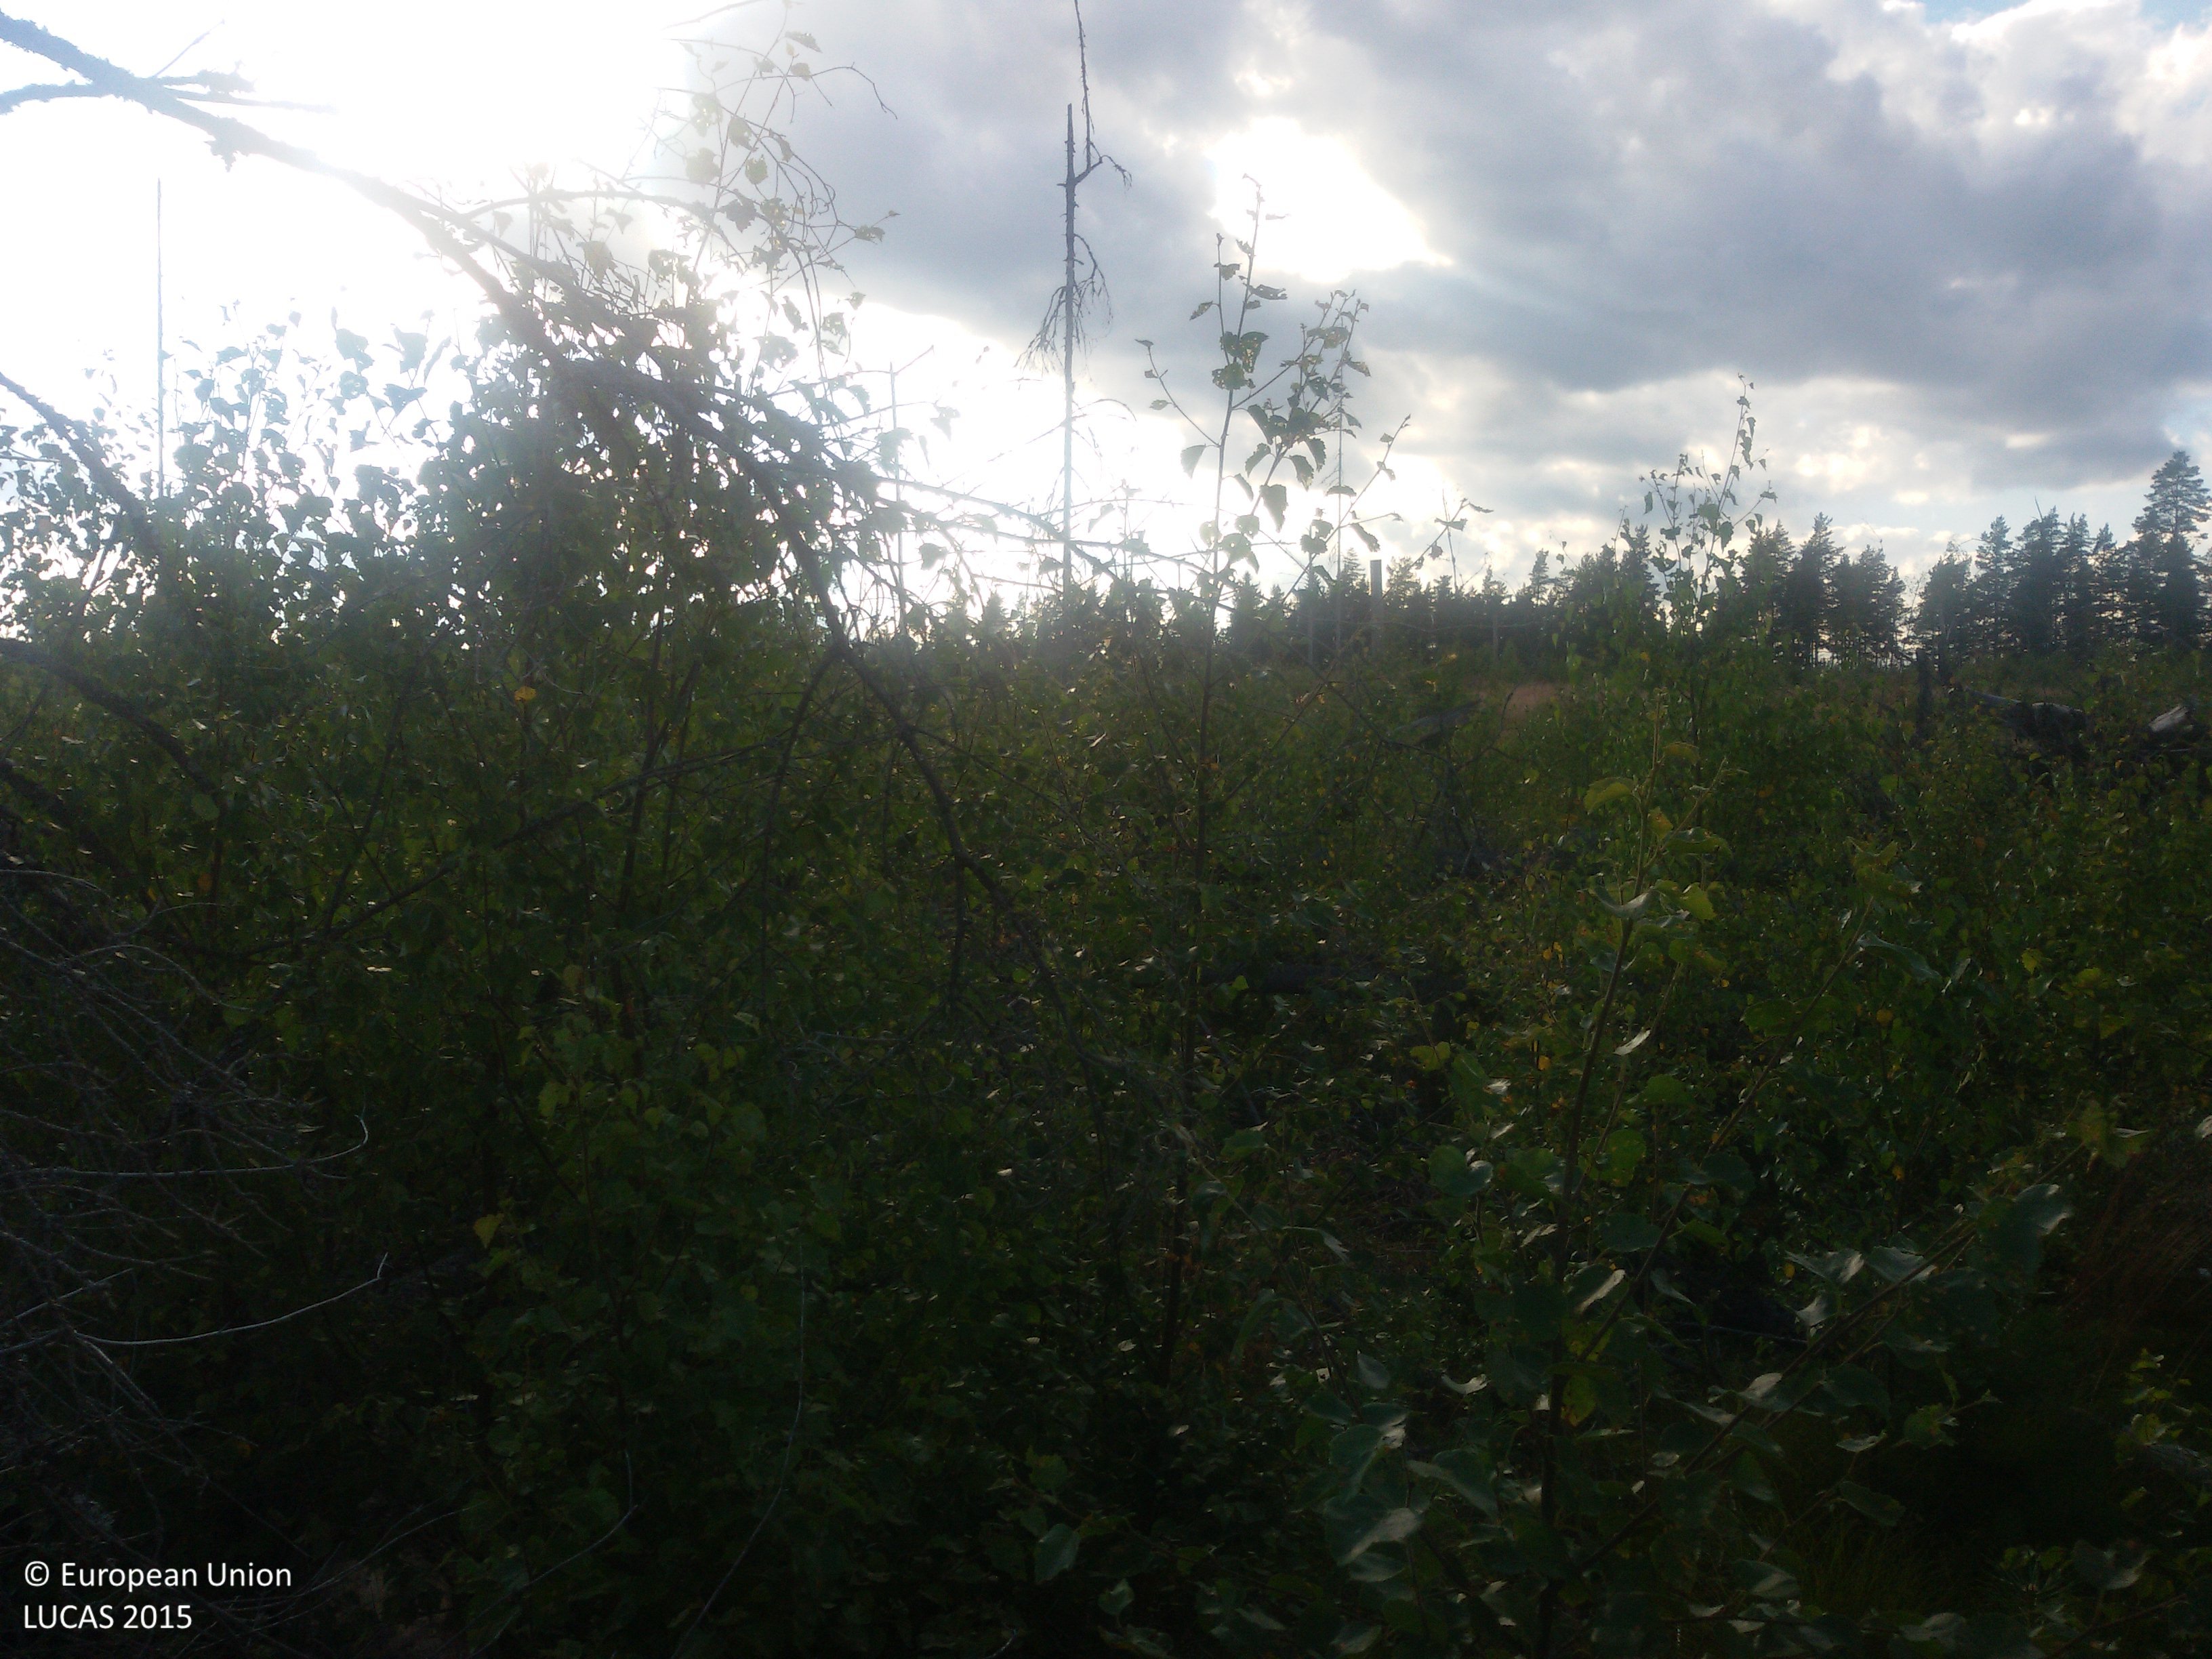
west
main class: Woodland
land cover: Pine dominated mixed woodland
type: boreal forest
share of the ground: > 75 %
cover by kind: broadleaved forest trees 45 %, coniferous forest trees 30 %, herbaceous plants 25 %
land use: Forestry
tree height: < 5 m
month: August
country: SE
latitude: 60.6183
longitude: 16.6942
